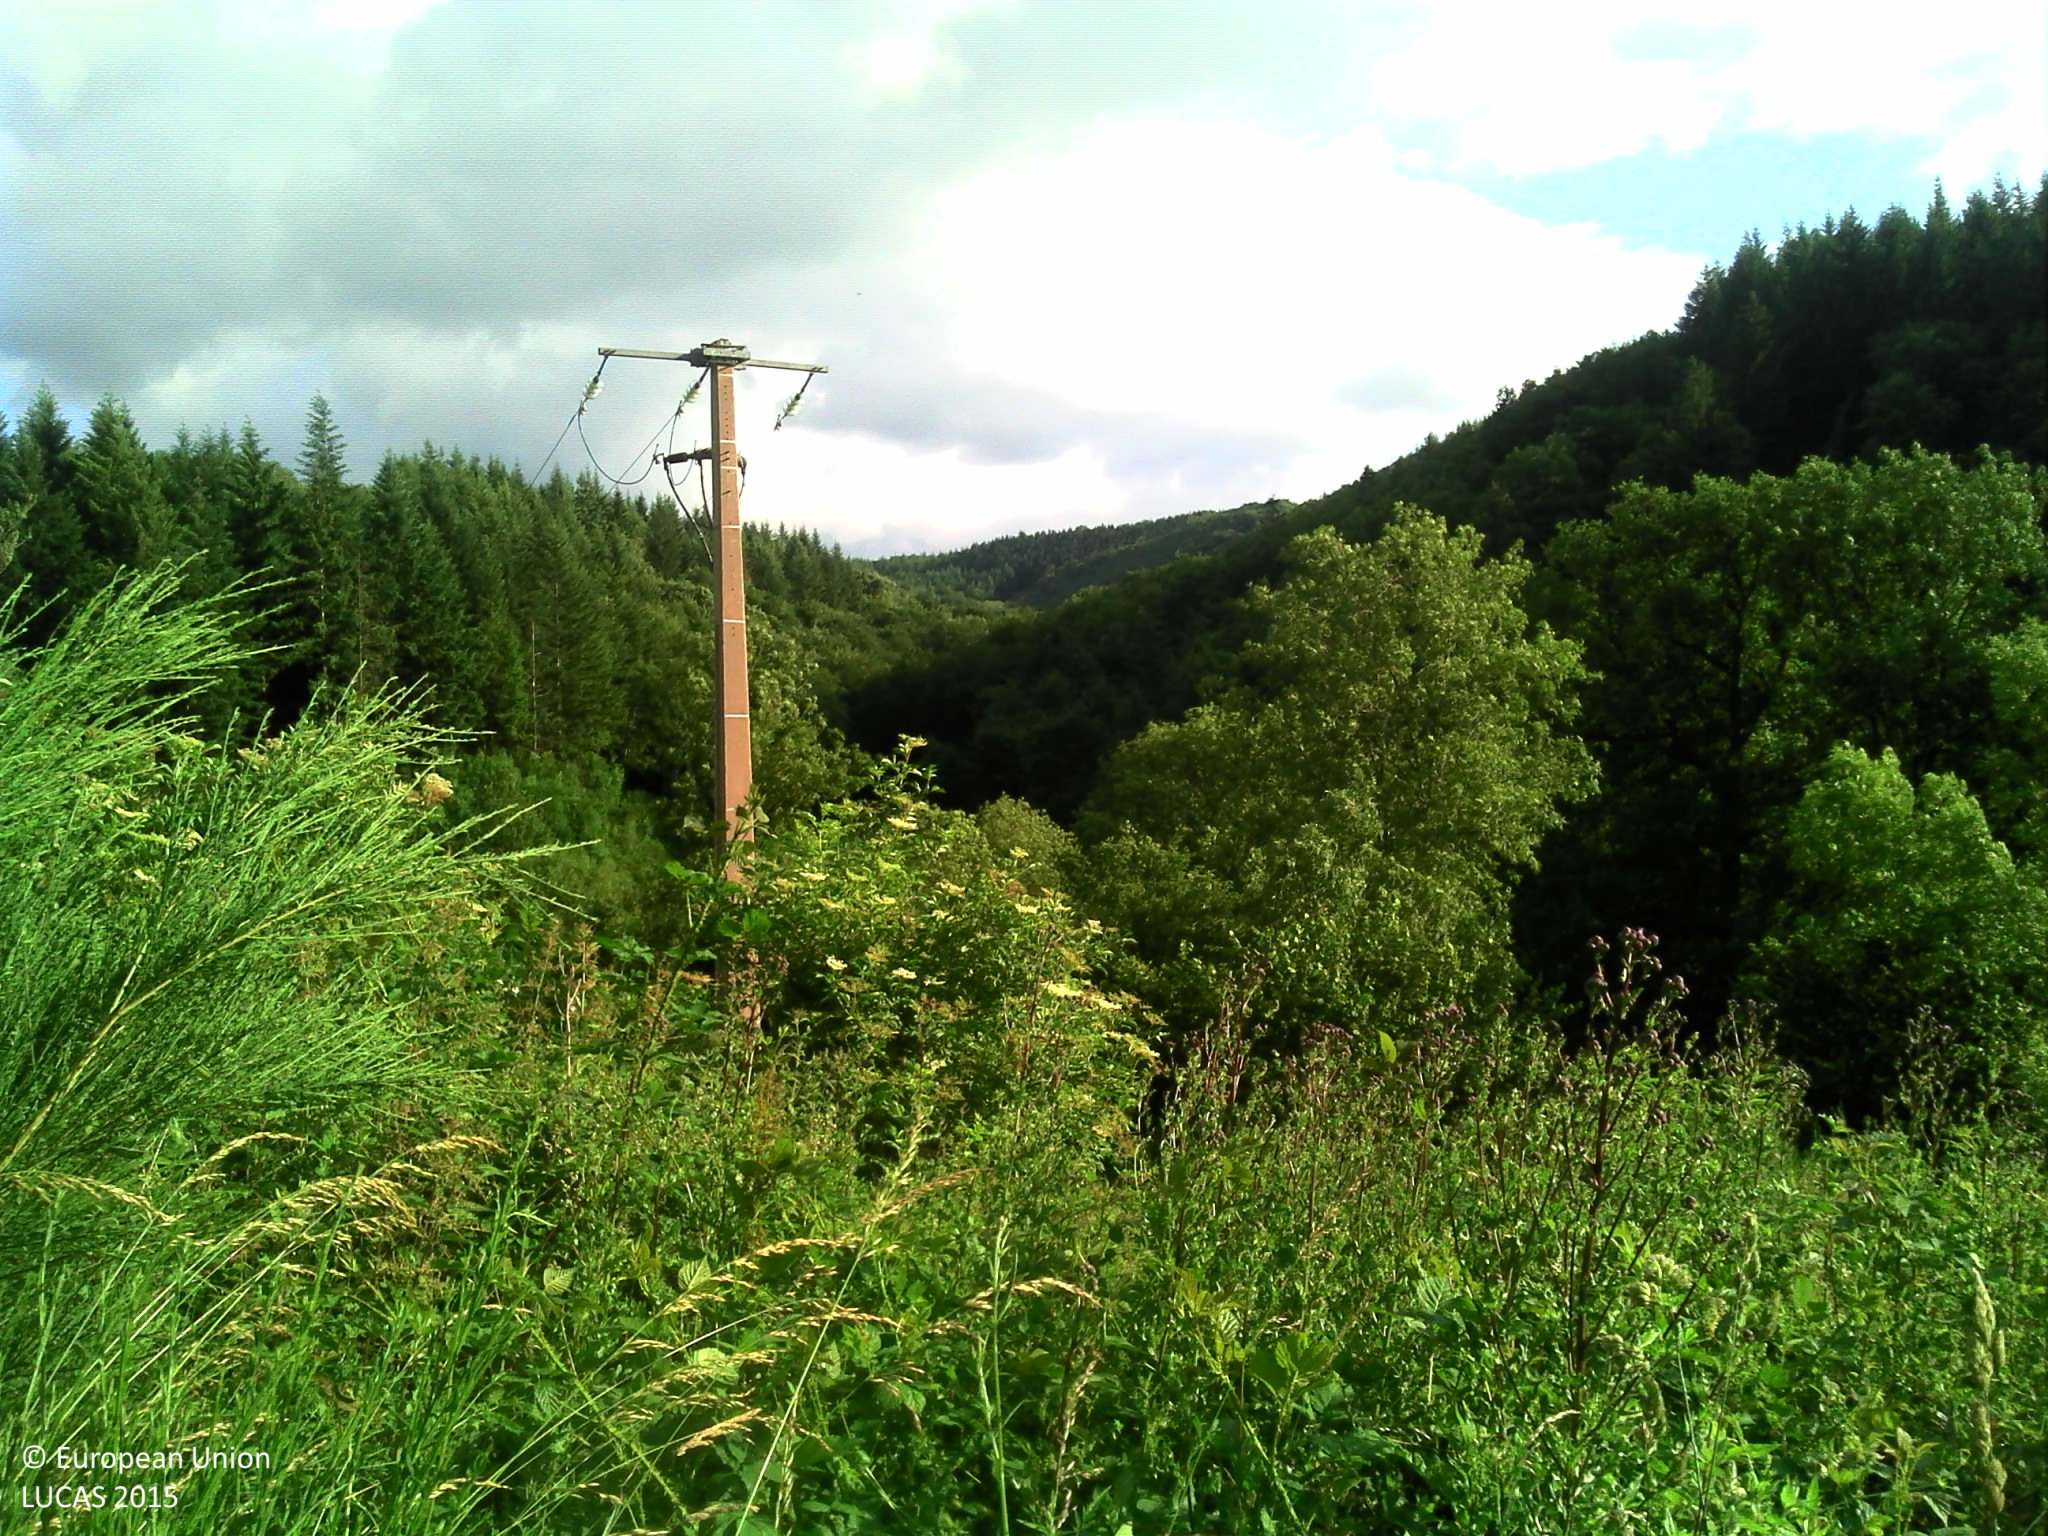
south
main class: Woodland
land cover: Spruce dominated coniferous woodland
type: exotic forest
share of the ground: > 75 %
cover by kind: coniferous forest trees 100 %
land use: Forestry
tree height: > 5 m
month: November
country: FR
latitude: 43.7936
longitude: 2.5615
